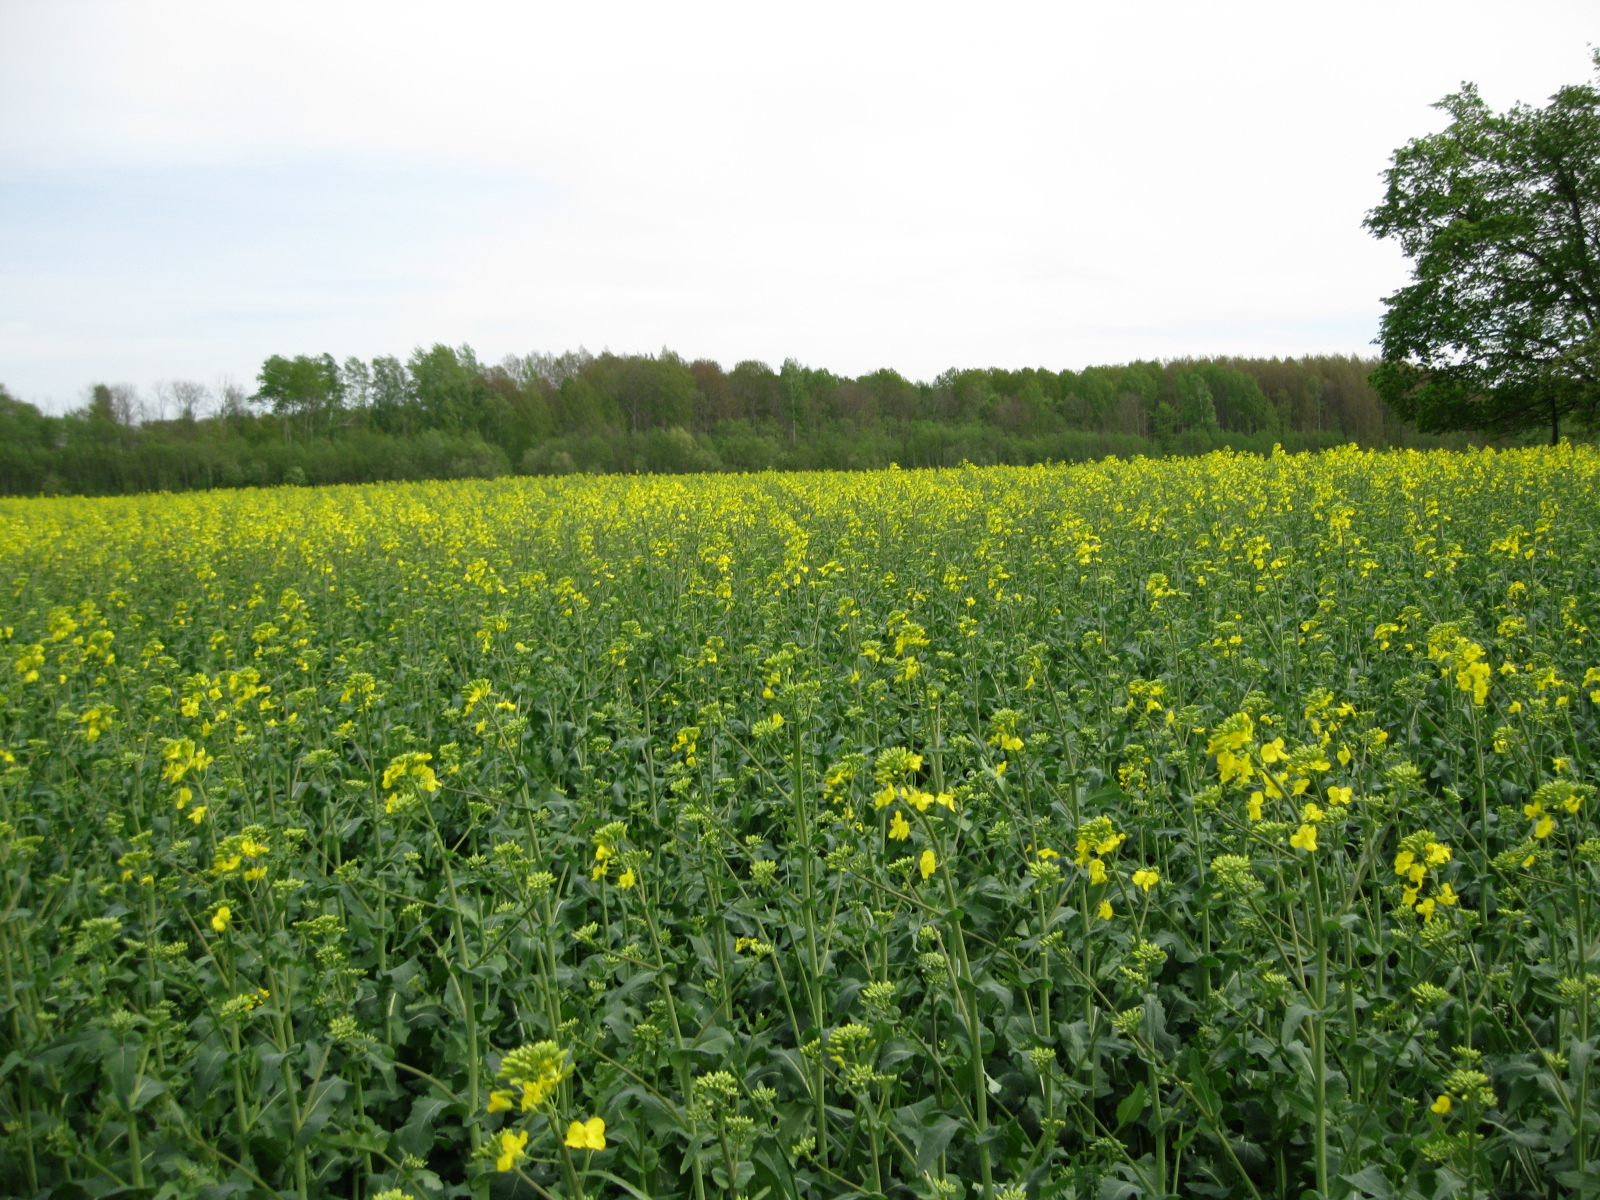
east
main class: Cropland
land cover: Rape and turnip rape
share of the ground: > 75 %
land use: Agriculture (excluding fallow land and kitchen gardens)
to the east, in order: Rape and turnip rape
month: May
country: LT
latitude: 56.2647
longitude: 24.2510
